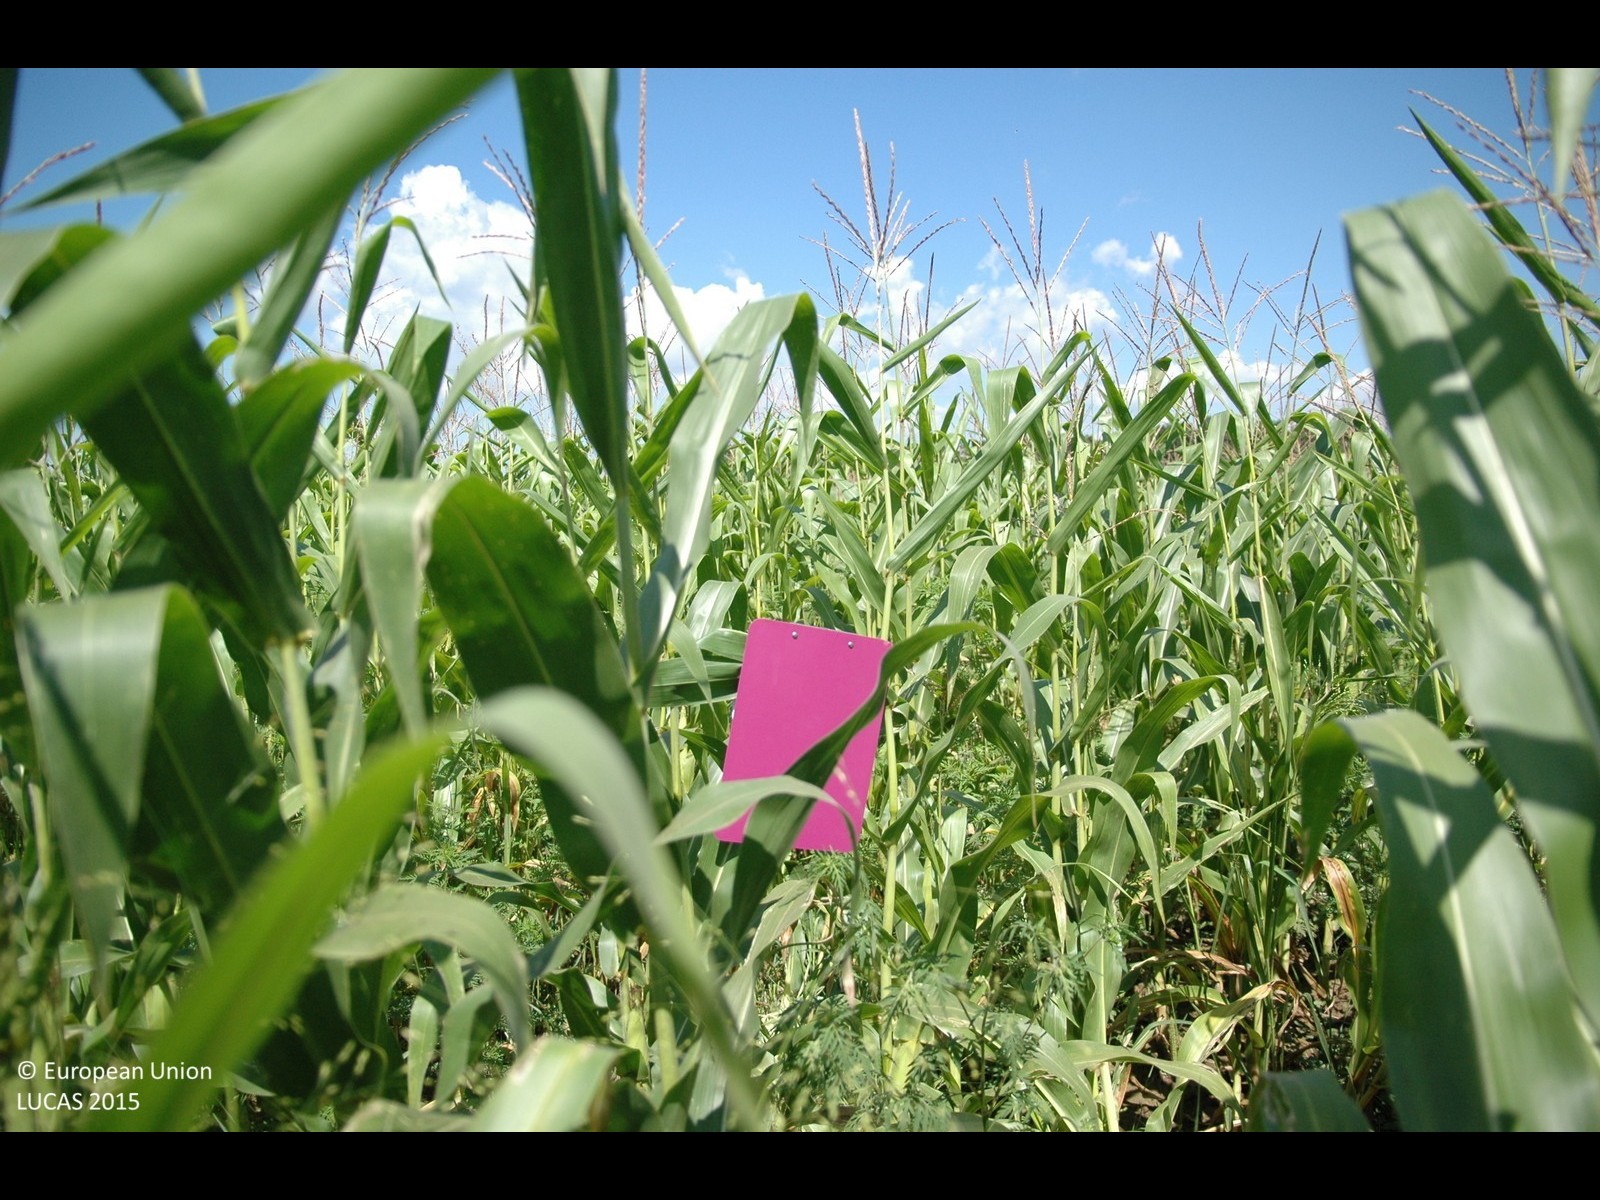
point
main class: Cropland
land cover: Maize
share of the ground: > 75 %
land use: Agriculture (excluding fallow land and kitchen gardens)
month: July
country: HR
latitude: 46.1838
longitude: 16.8808
